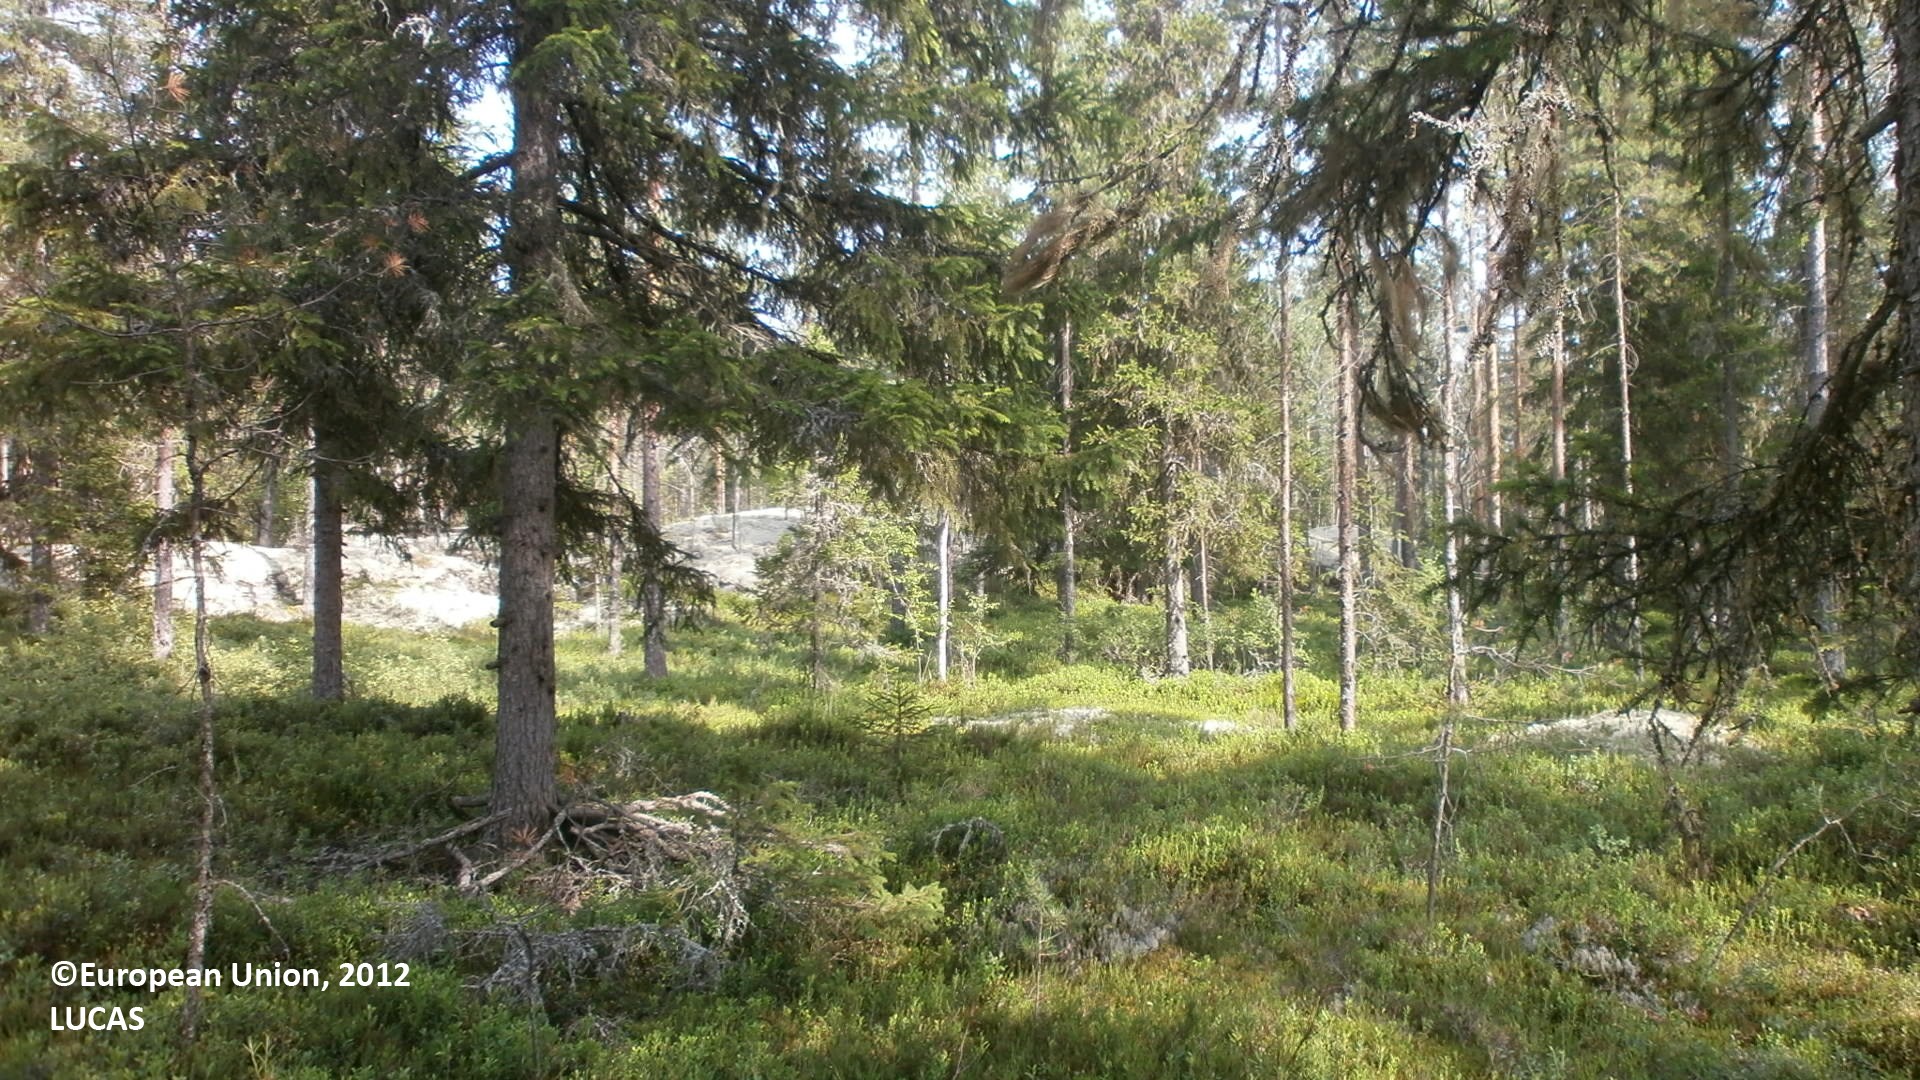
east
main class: Woodland
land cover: Other coniferous woodland
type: boreal forest
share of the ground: 50 - 75 %
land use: Forestry
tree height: > 5 m
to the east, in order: Other coniferous woodland; Pine dominated coniferous woodland; Tracks; Pine dominated coniferous woodland; Ditches and canals; Pine dominated coniferous woodland; Ditches and canals; Pine dominated coniferous woodland; Ditches and canals; Pine dominated coniferous woodland
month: July
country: FI
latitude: 64.3054
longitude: 24.2263
